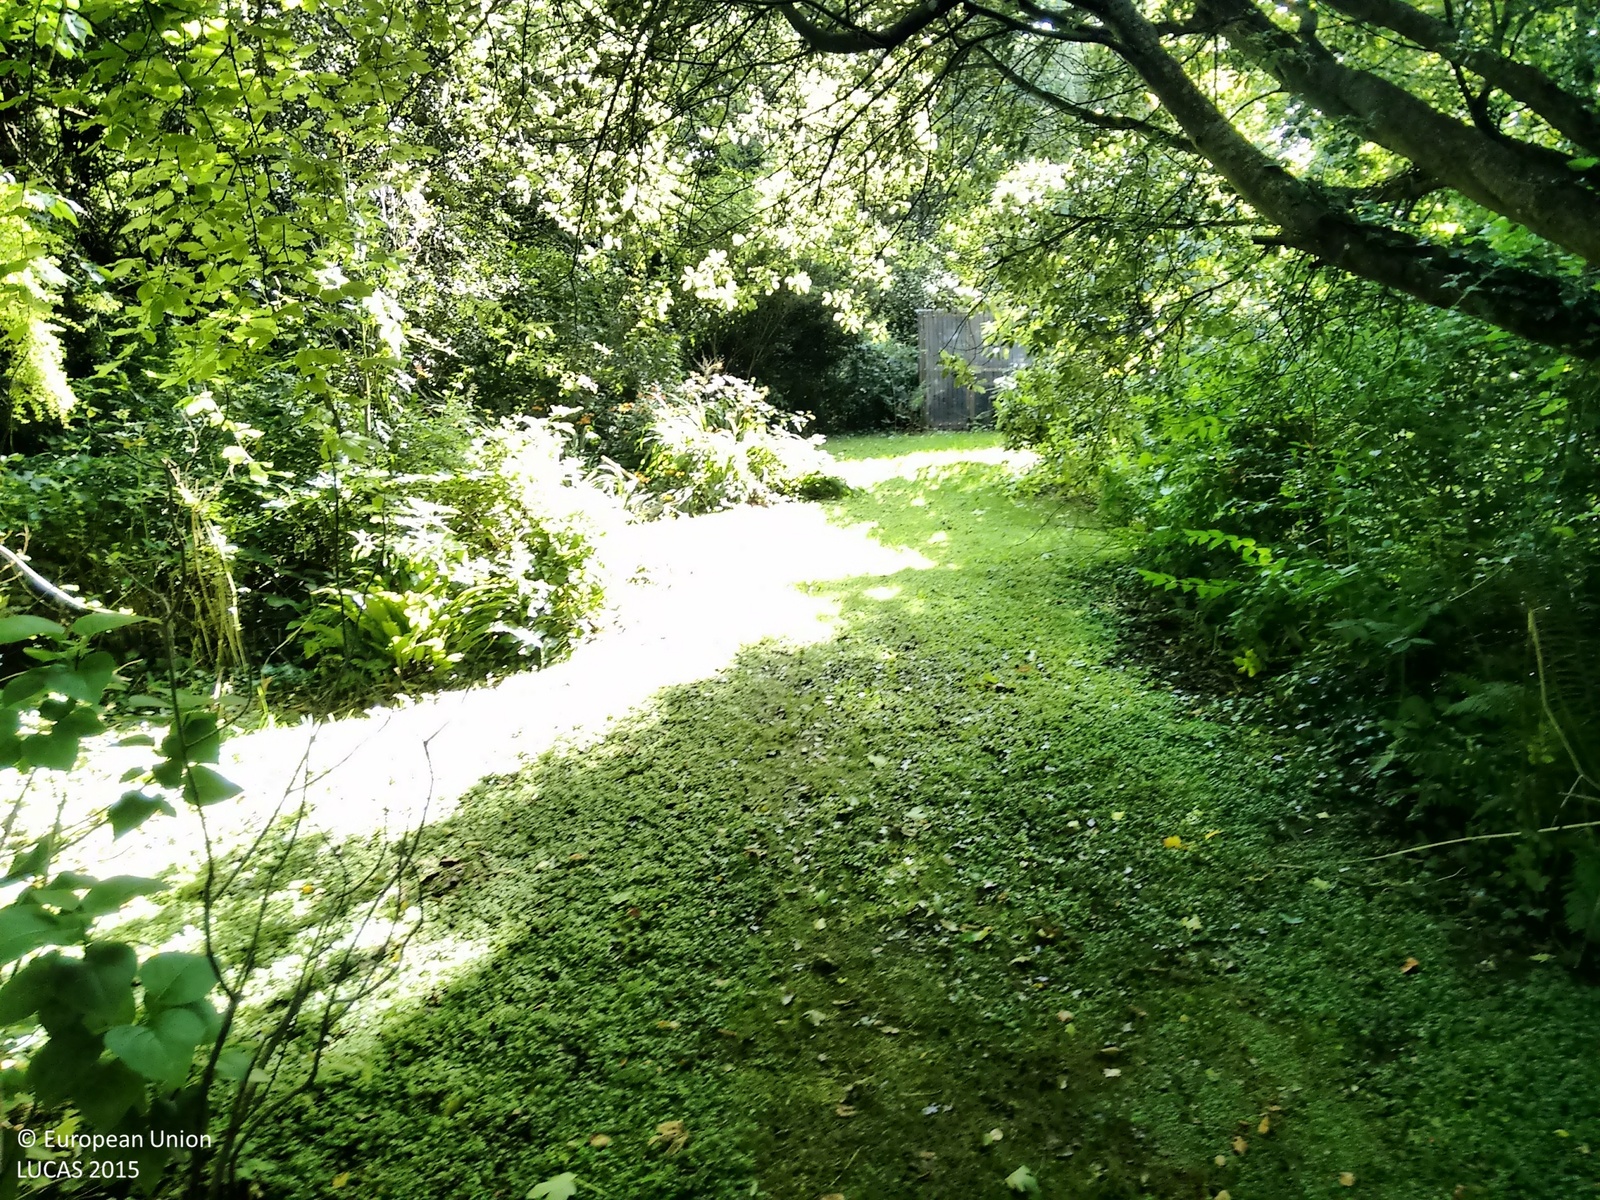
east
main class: Woodland
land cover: Broadleaved woodland
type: mesophytic deciduous forest
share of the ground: > 75 %
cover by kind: broadleaved forest trees 100 %
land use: Residential
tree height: > 5 m
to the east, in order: Broadleaved woodland; Rivers and streams; Broadleaved woodland; Artificial constructions; Grassland without tree/shrub cover; Broadleaved woodland
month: August
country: GB
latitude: 50.1695
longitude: -5.4284
